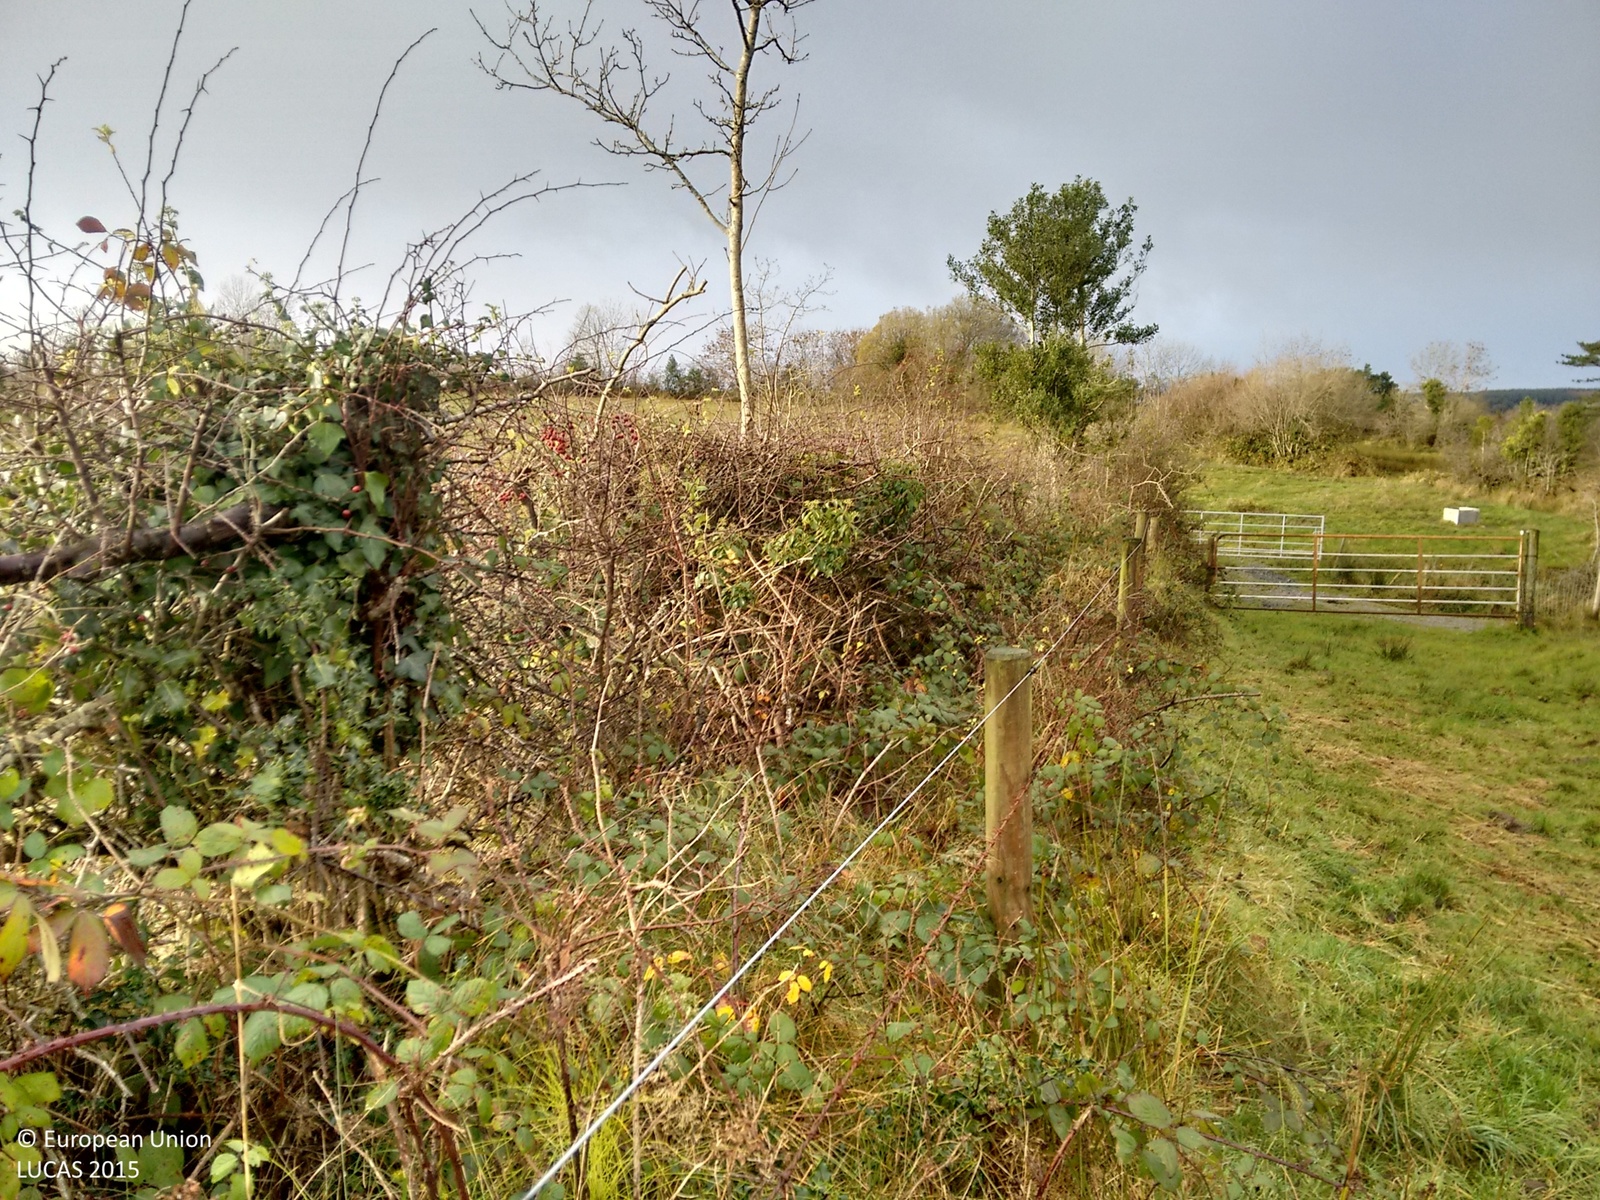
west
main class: Grassland
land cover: Grassland without tree/shrub cover
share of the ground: > 75 %
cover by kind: herbaceous plants 100 %
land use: Agriculture (excluding fallow land and kitchen gardens)
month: November
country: IE
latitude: 53.9883
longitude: -7.7820
